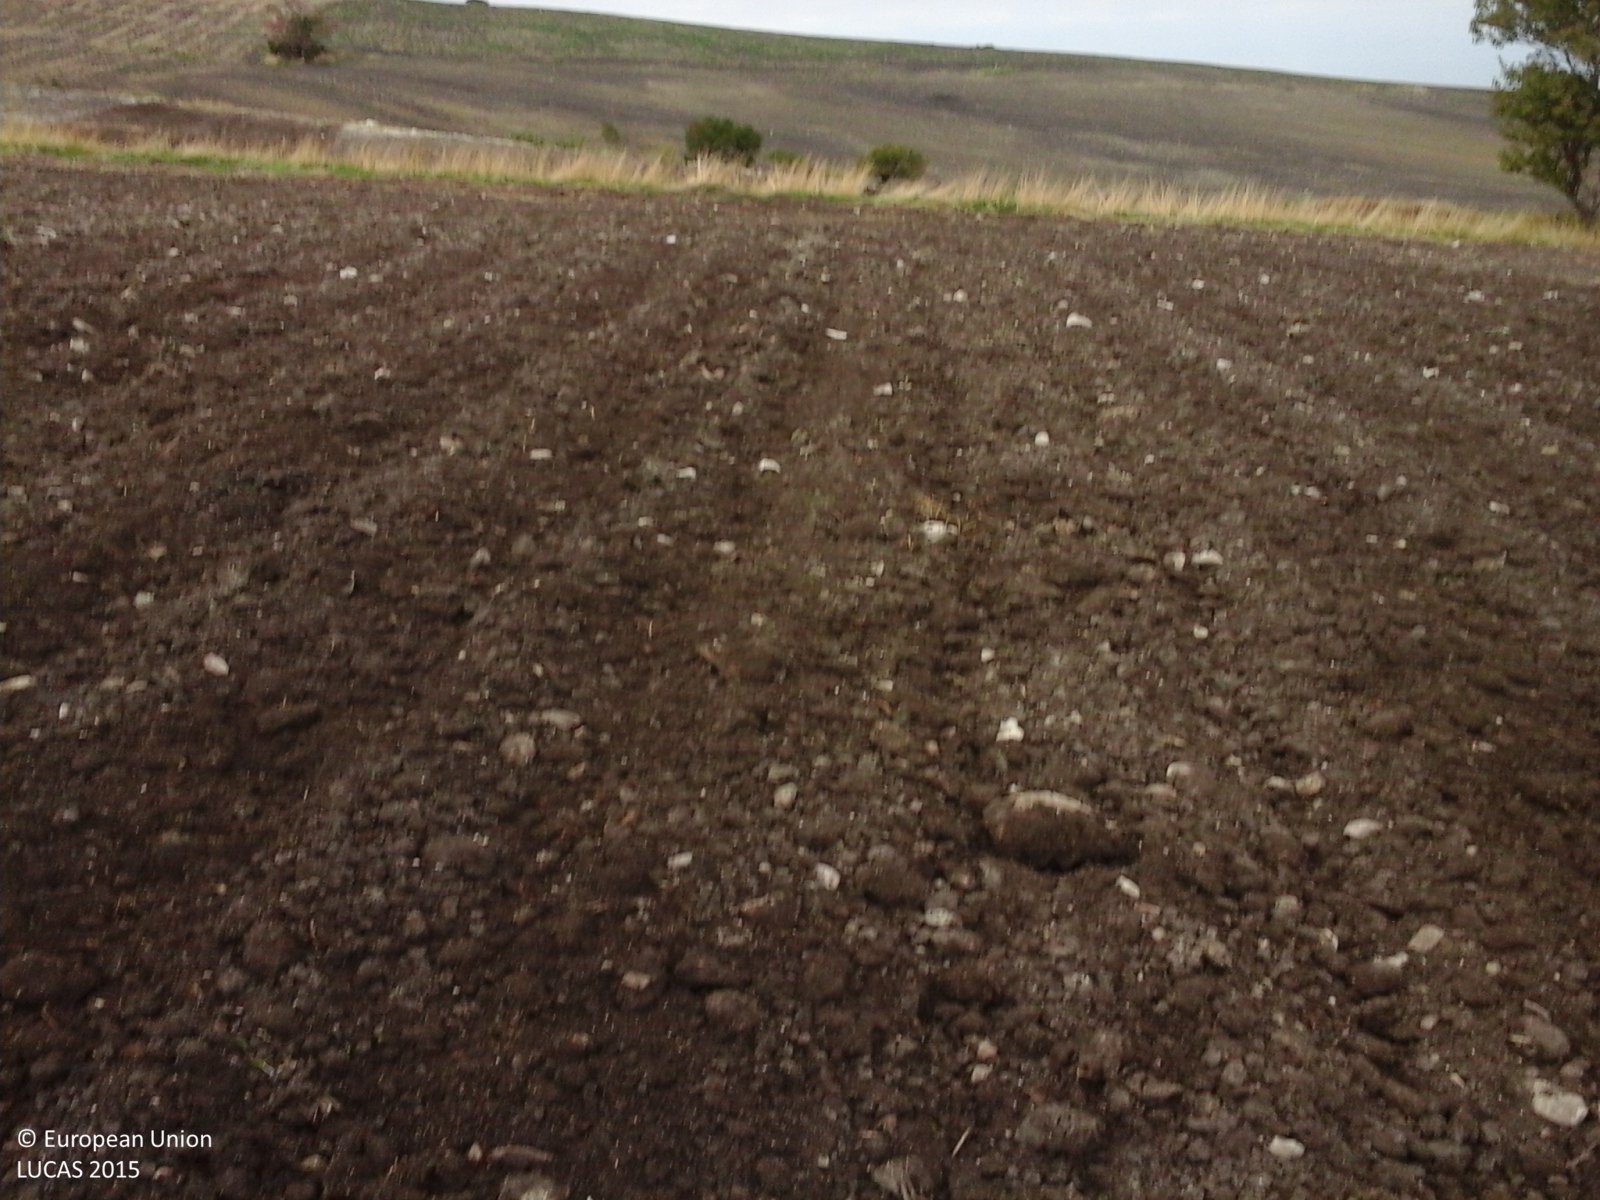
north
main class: Cropland
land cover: Durum wheat
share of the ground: > 75 %
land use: Agriculture (excluding fallow land and kitchen gardens)
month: October
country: IT
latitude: 41.5636
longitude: 15.1511
